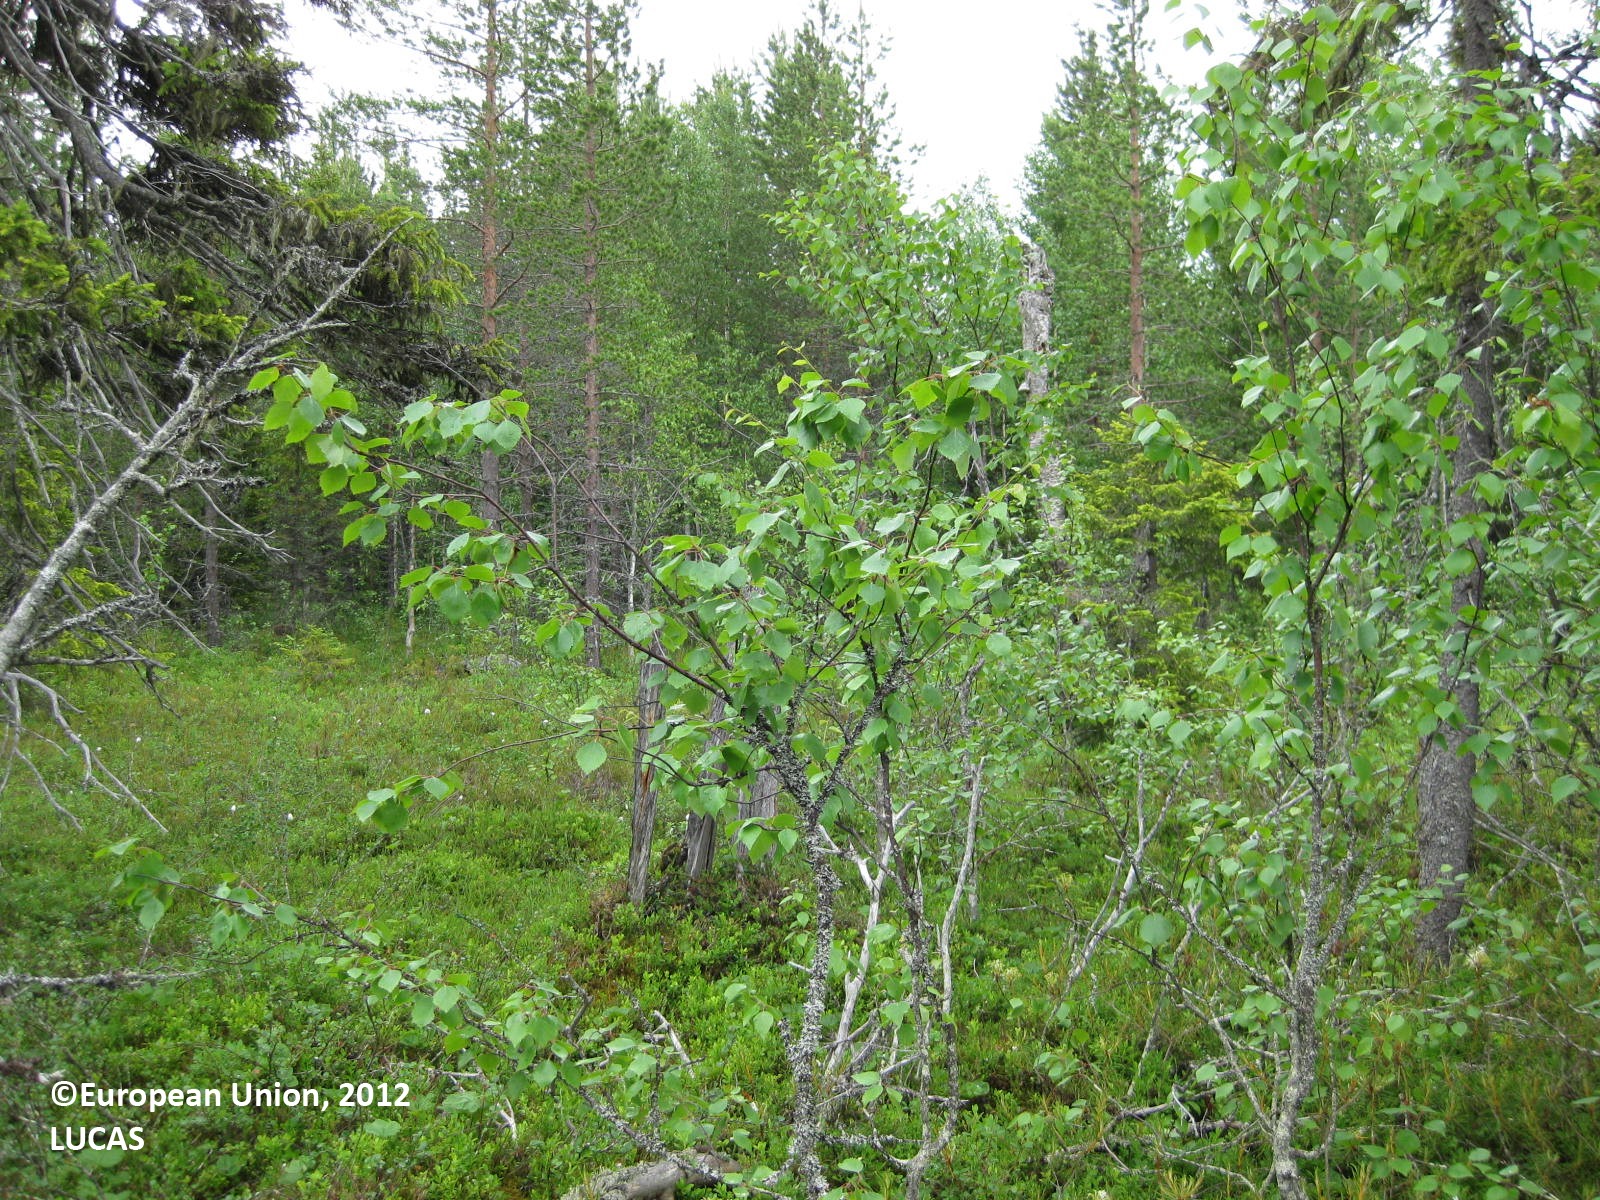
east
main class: Woodland
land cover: Spruce dominated coniferous woodland
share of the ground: 25 - 50 %
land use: Forestry
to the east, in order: Spruce dominated coniferous woodland; Ditches and canals; Pine dominated mixed woodland; Ditches and canals; Pine dominated mixed woodland; Ditches and canals; Other mixed woodland; Ditches and canals; Pine dominated coniferous woodland; Ditches and canals; Pine dominated mixed woodland; Ditches and canals; Other mixed woodland; Grassland without tree/shrub cover; Pine dominated coniferous woodland; Ditches and canals; Pine dominated coniferous woodland; Ditches and canals; Pine dominated coniferous woodland; Ditches and canals; Pine dominated coniferous woodland; Ditches and canals; Pine dominated coniferous woodland; Ditches and canals; Pine dominated coniferous woodland; Ditches and canals; Pine dominated coniferous woodland; Ditches and canals; Pine dominated coniferous woodland; Ditches and canals; Pine dominated coniferous woodland; Ditches and canals; Pine dominated coniferous woodland; Ditches and canals; Pine dominated coniferous woodland; Ditches and canals; Pine dominated coniferous woodland; Ditches and canals; Pine dominated coniferous woodland; Ditches and canals; Pine dominated coniferous woodland; Ditches and canals; Pine dominated coniferous woodland; Ditches and canals; Pine dominated coniferous woodland; Ditches and canals; Pine dominated coniferous woodland; Ditches and canals; Pine dominated coniferous woodland; Ditches and canals; Pine dominated coniferous woodland; Ditches and canals; Pine dominated coniferous woodland; Ditches and canals; Pine dominated mixed woodland; Ditches and canals; Pine dominated mixed woodland; Ditches and canals; Pine dominated coniferous woodland; Ditches and canals; Pine dominated coniferous woodland; Ditches and canals; Pine dominated coniferous woodland; Ditches and canals; Other mixed woodland; Ditches and canals; Pine dominated coniferous woodland; Ditches and canals; Pine dominated coniferous woodland; Ditches and canals; Pine dominated coniferous woodland; Ditches and canals; Pine dominated mixed woodland; Ditches and canals; Pine dominated mixed woodland; Ditches and canals; Pine dominated mixed woodland; Ditches and canals; Pine dominated coniferous woodland
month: July
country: FI
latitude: 65.4562
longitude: 28.3894
